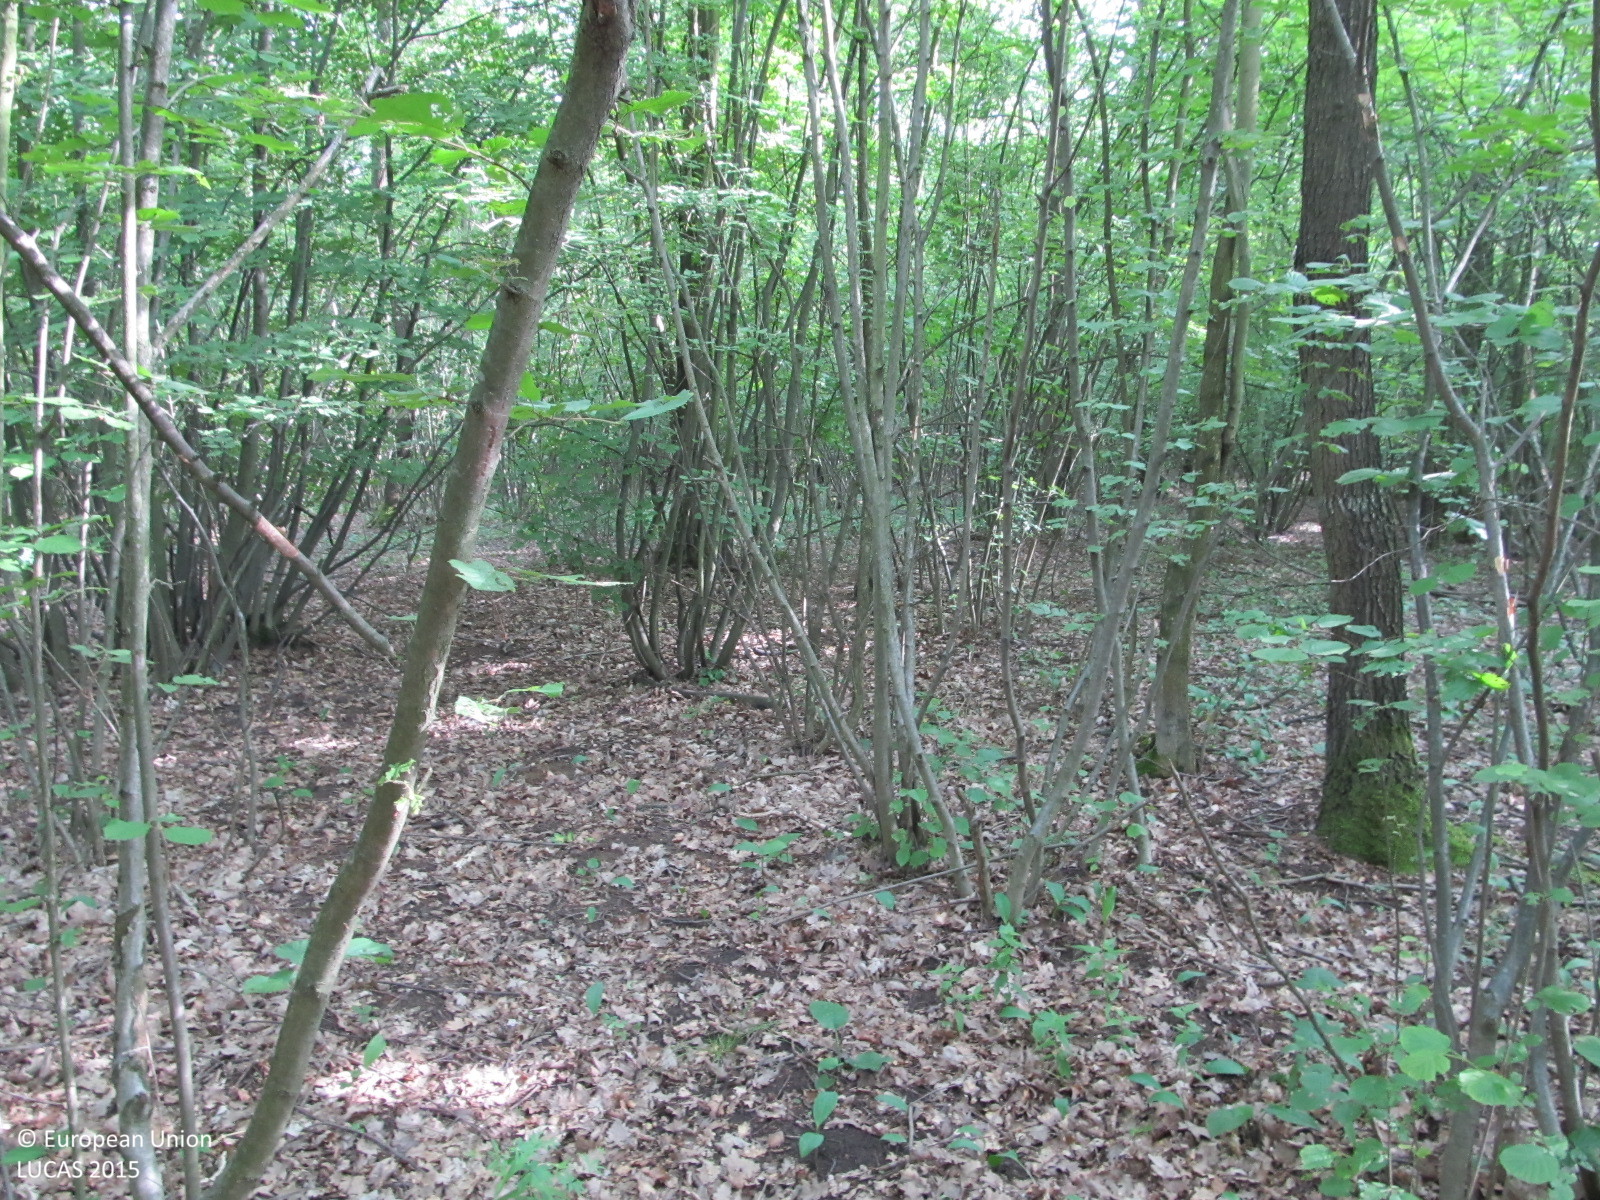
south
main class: Woodland
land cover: Broadleaved woodland
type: mesophytic deciduous forest
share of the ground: > 75 %
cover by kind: broadleaved forest trees 80 %, unconsolidated bare surface 10 %, shrubs 5 %, herbaceous plants 5 %
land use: Forestry
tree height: > 5 m
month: June
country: AT
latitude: 48.6650
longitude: 16.1558
